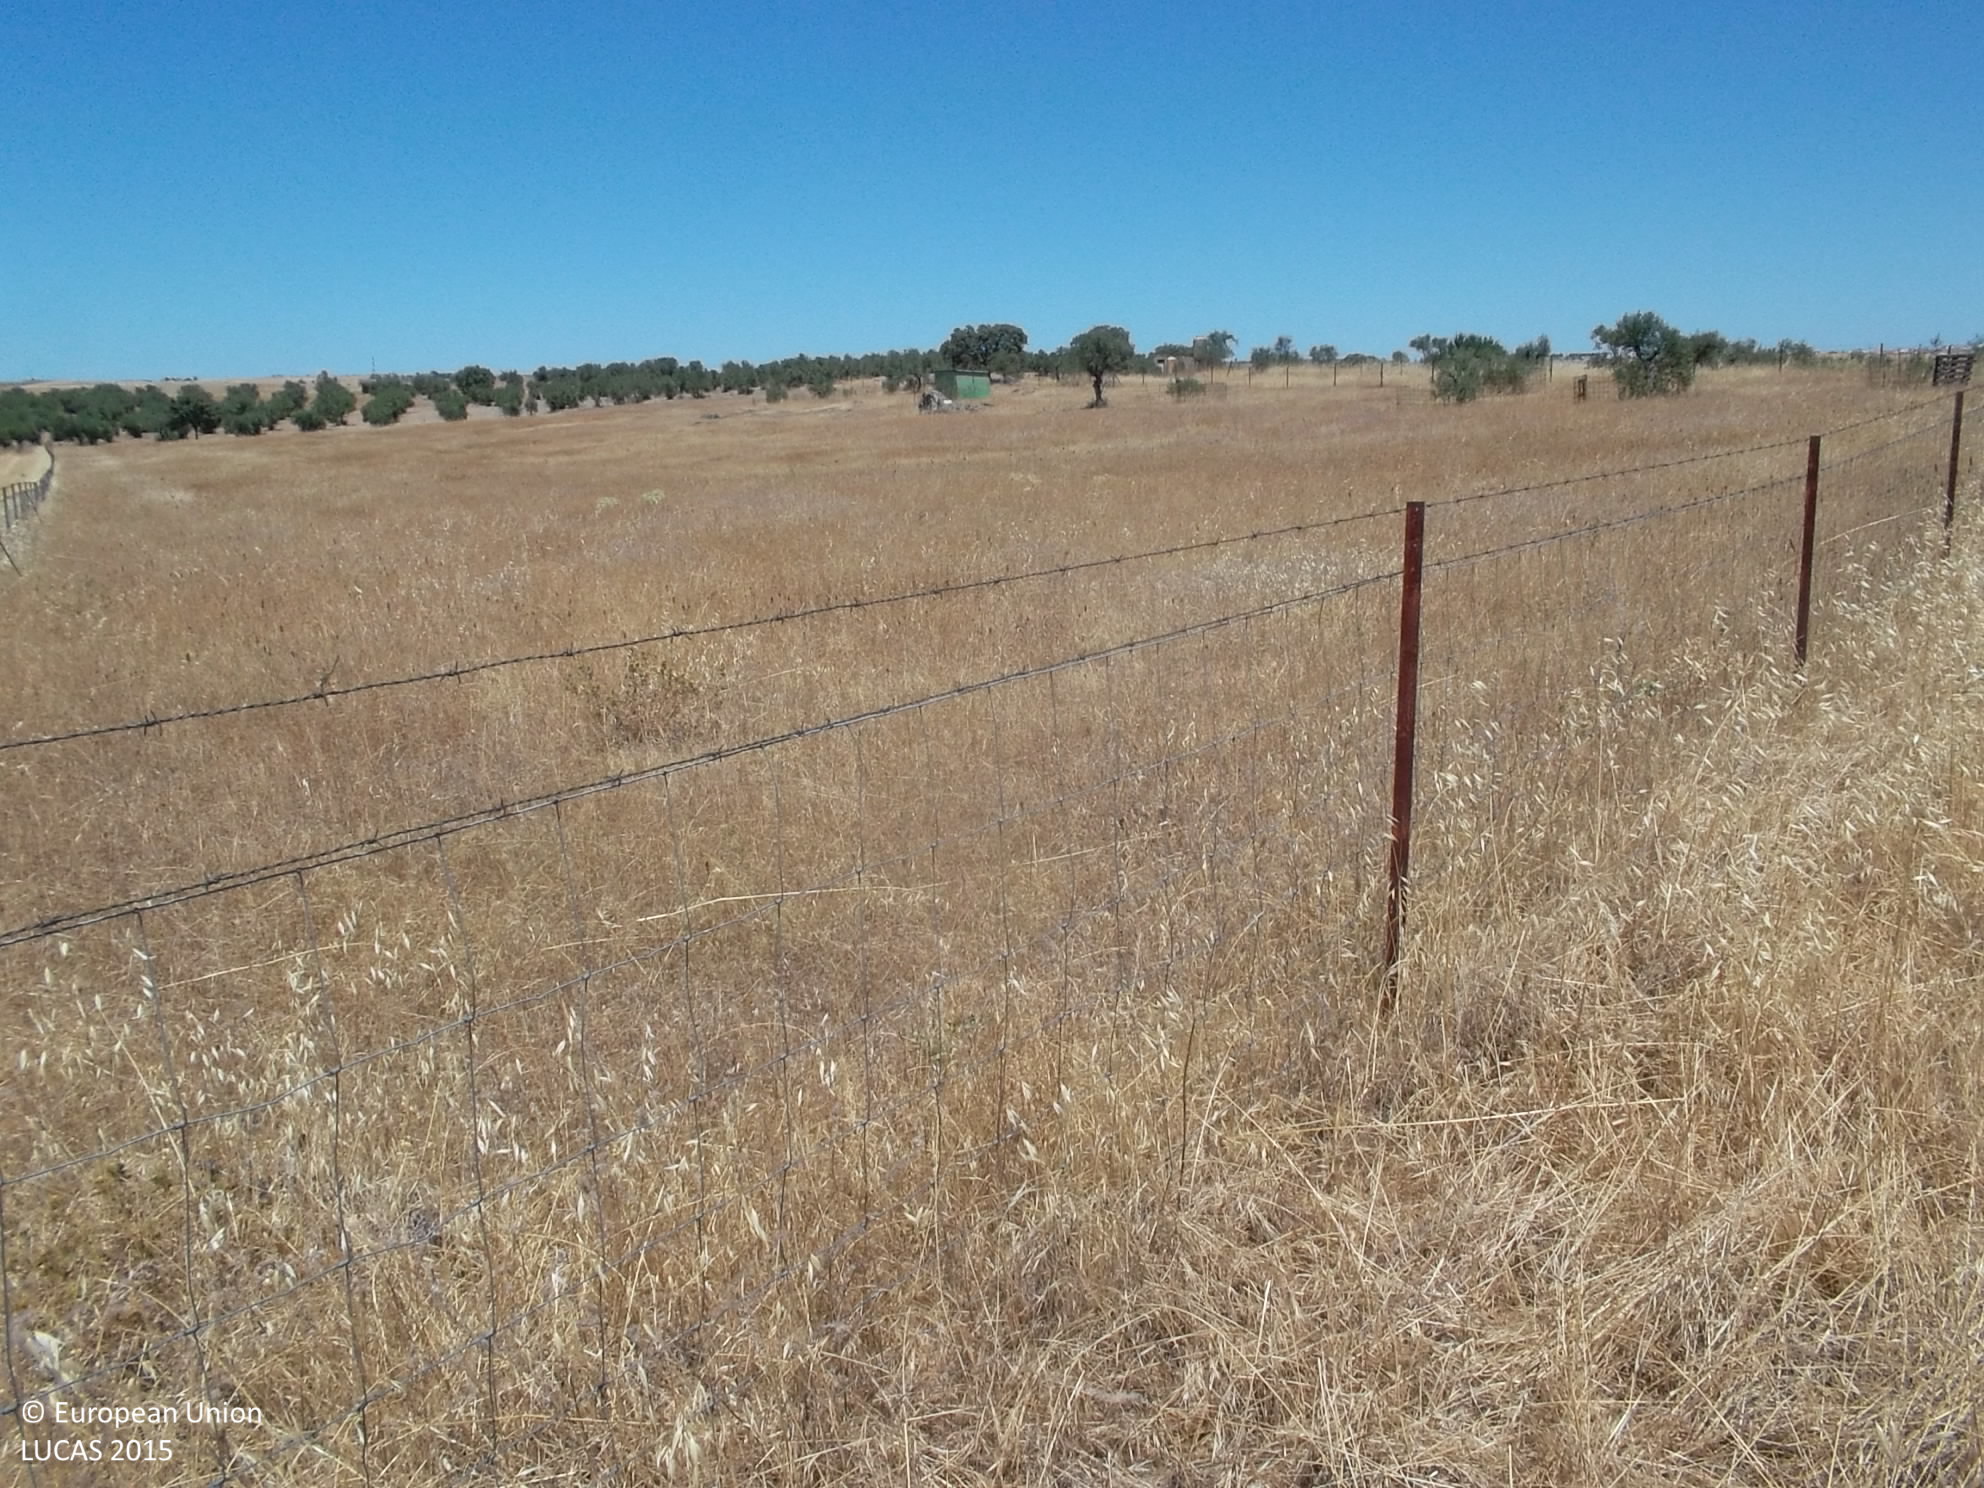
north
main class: Cropland
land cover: Mixed cereals for fodder
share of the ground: < 10 %
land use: Agriculture (excluding fallow land and kitchen gardens)
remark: Harvested field
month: July
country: ES
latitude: 38.2225
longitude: -5.6943
